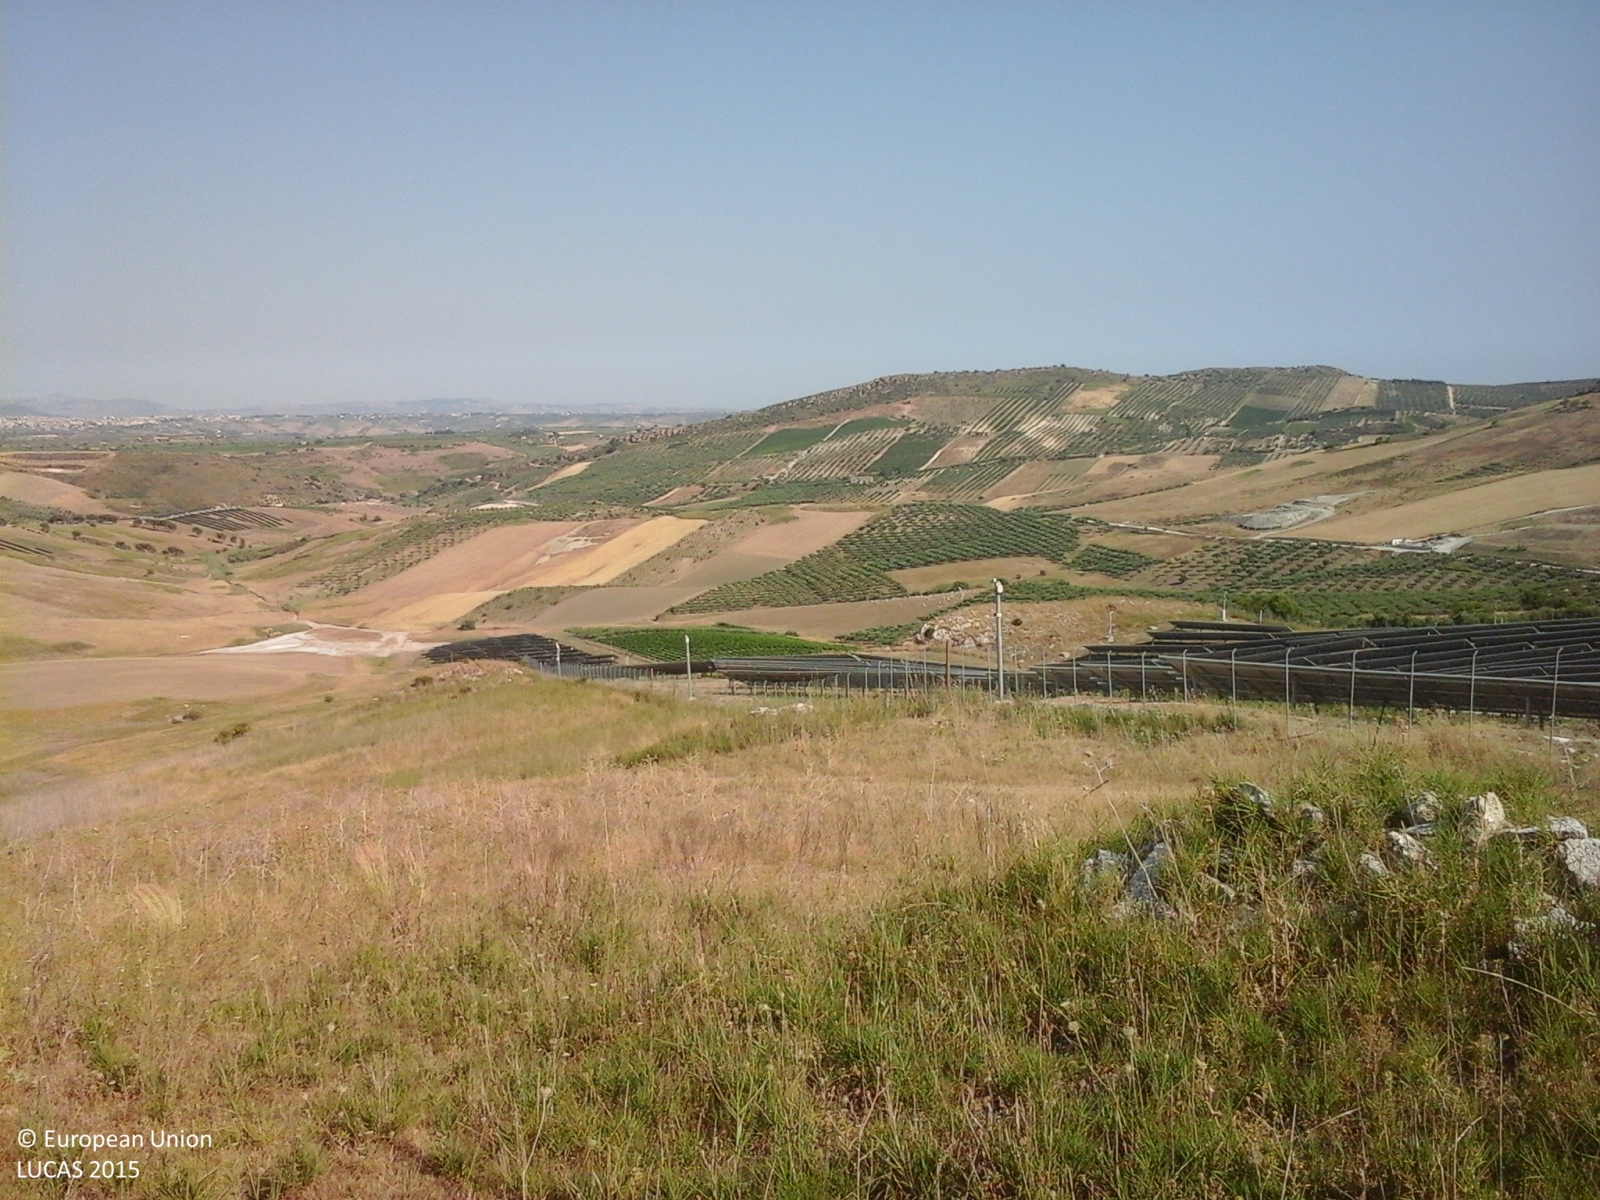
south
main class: Grassland
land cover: Grassland without tree/shrub cover
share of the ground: > 75 %
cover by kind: herbaceous plants 100 %
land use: Agriculture (excluding fallow land and kitchen gardens)
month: July
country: IT
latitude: 37.5309
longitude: 13.1782
